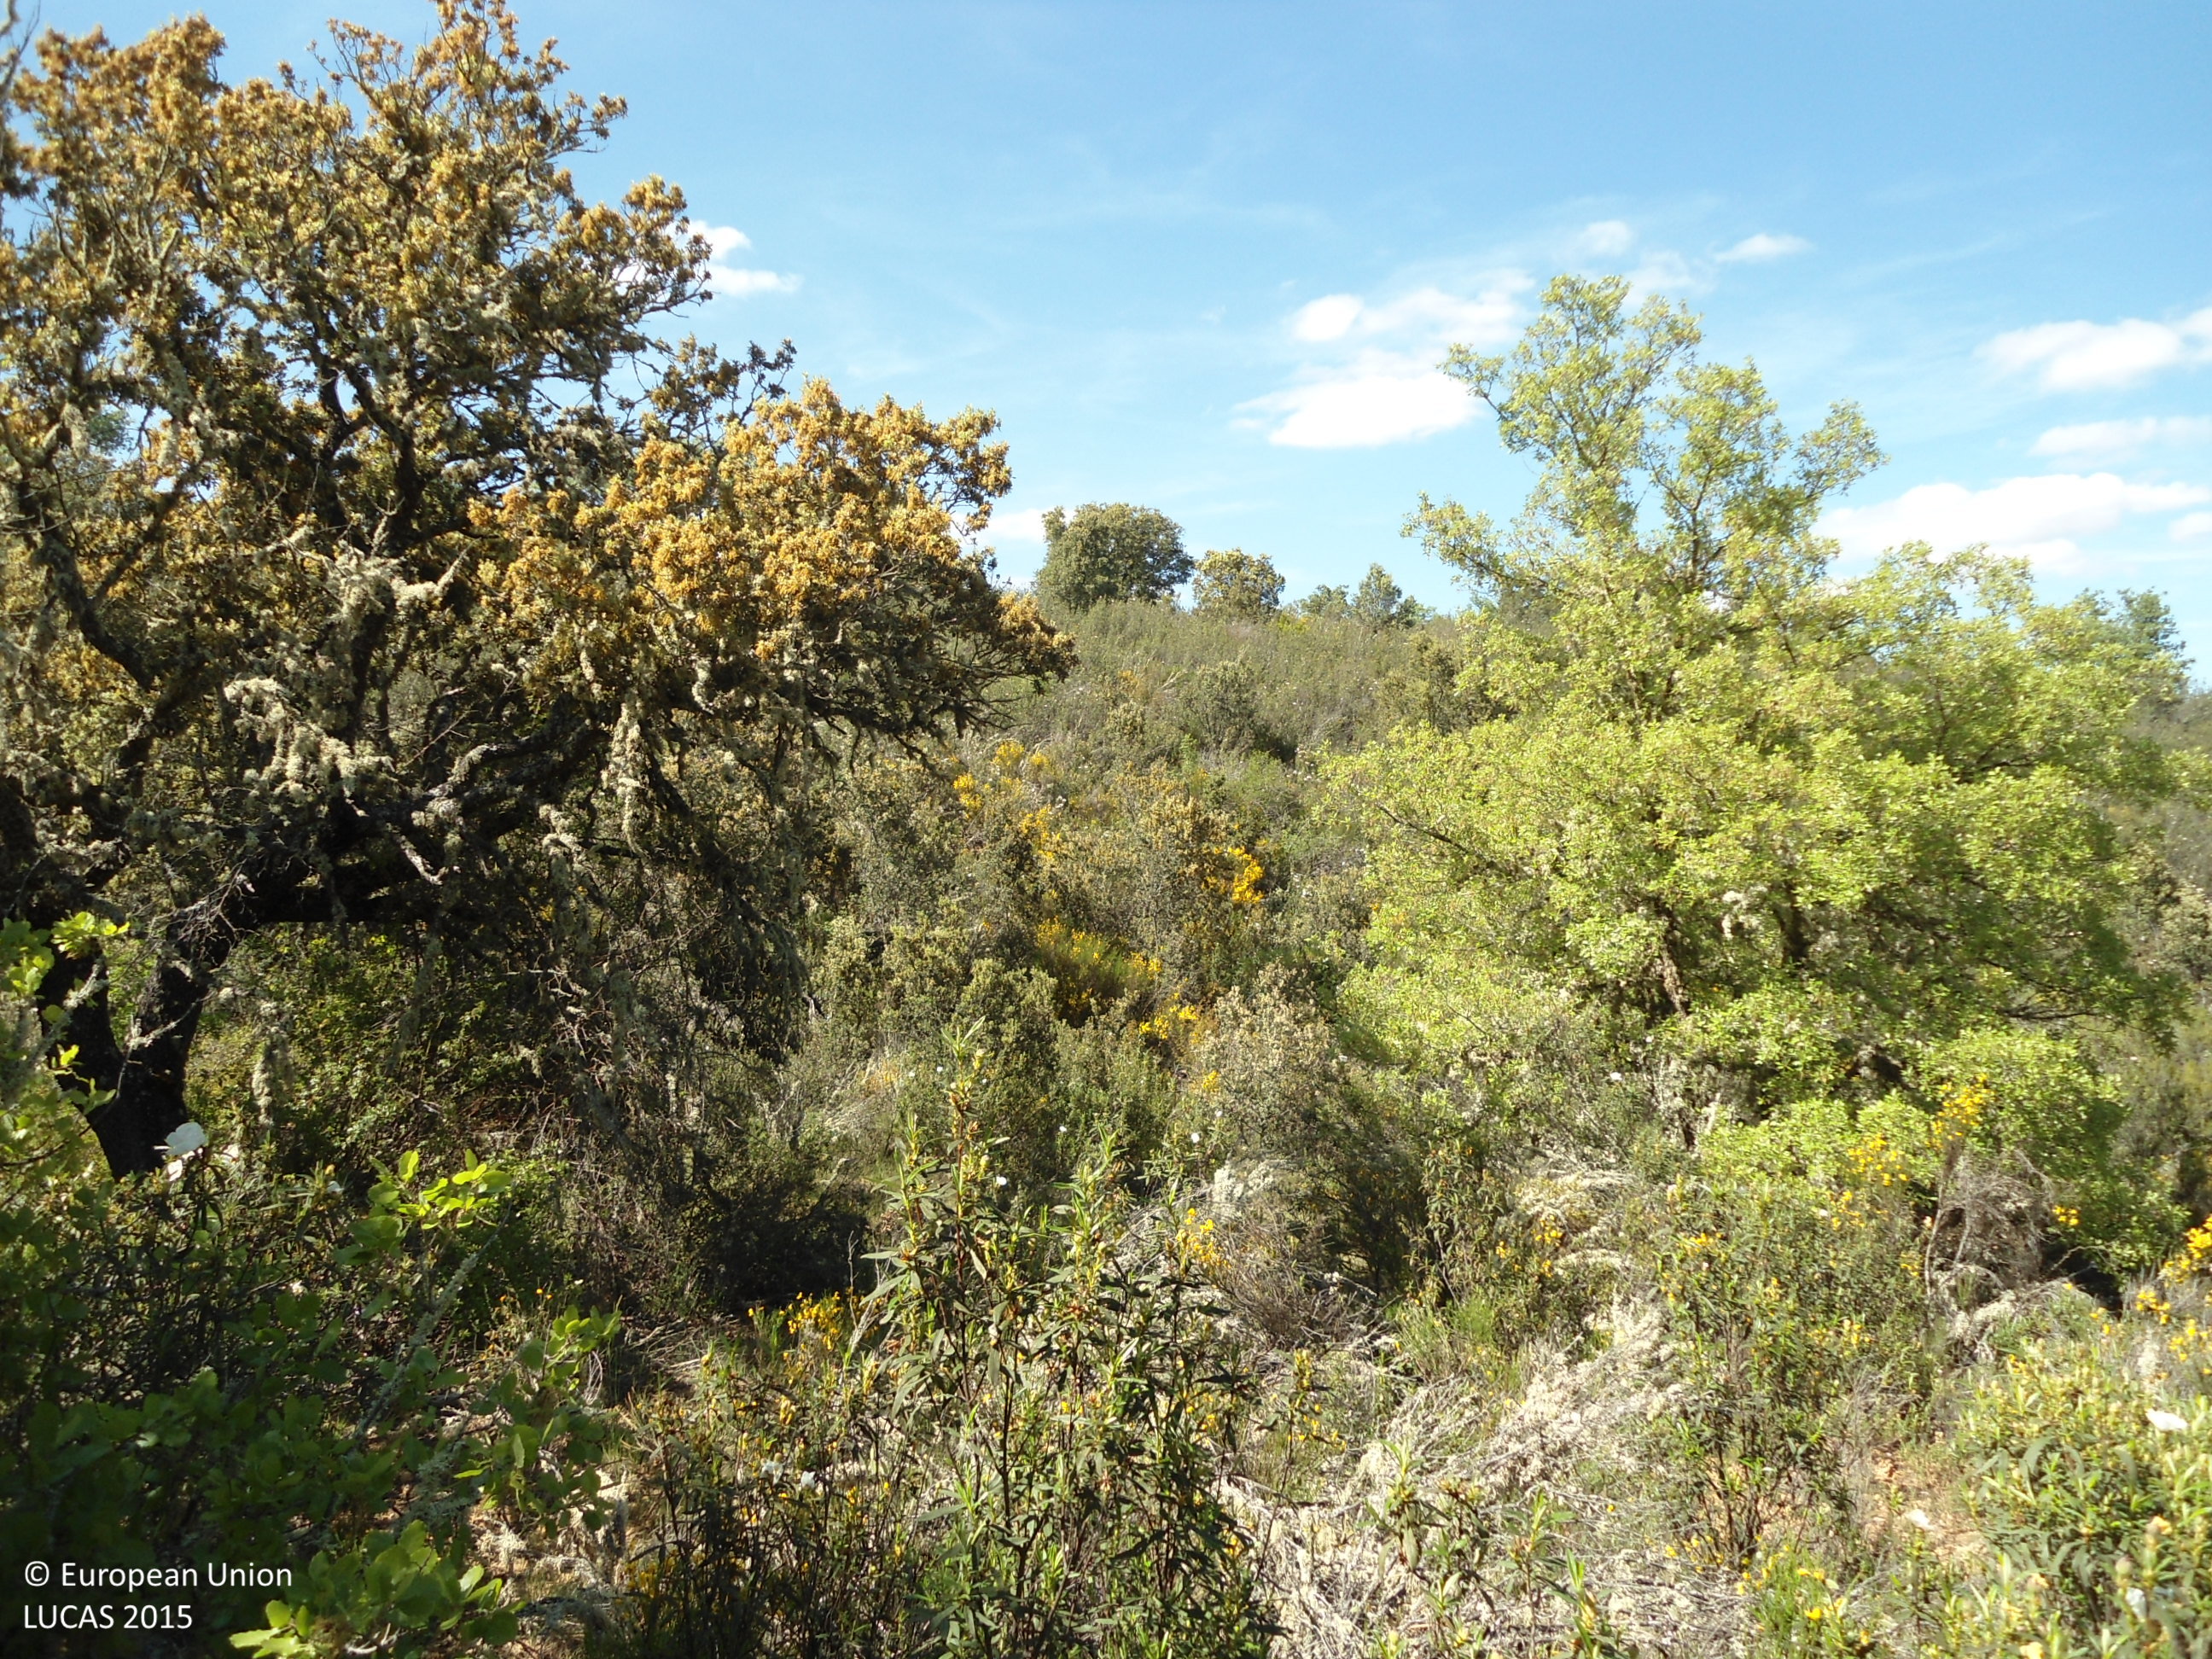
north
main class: Woodland
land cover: Broadleaved woodland
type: acidophilous oak and oak-birch forest
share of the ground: > 75 %
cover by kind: broadleaved forest trees 70 %, shrubs 30 %
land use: Semi-natural and natural areas not in use
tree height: > 5 m
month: May
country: ES
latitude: 41.9448
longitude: -5.9836
